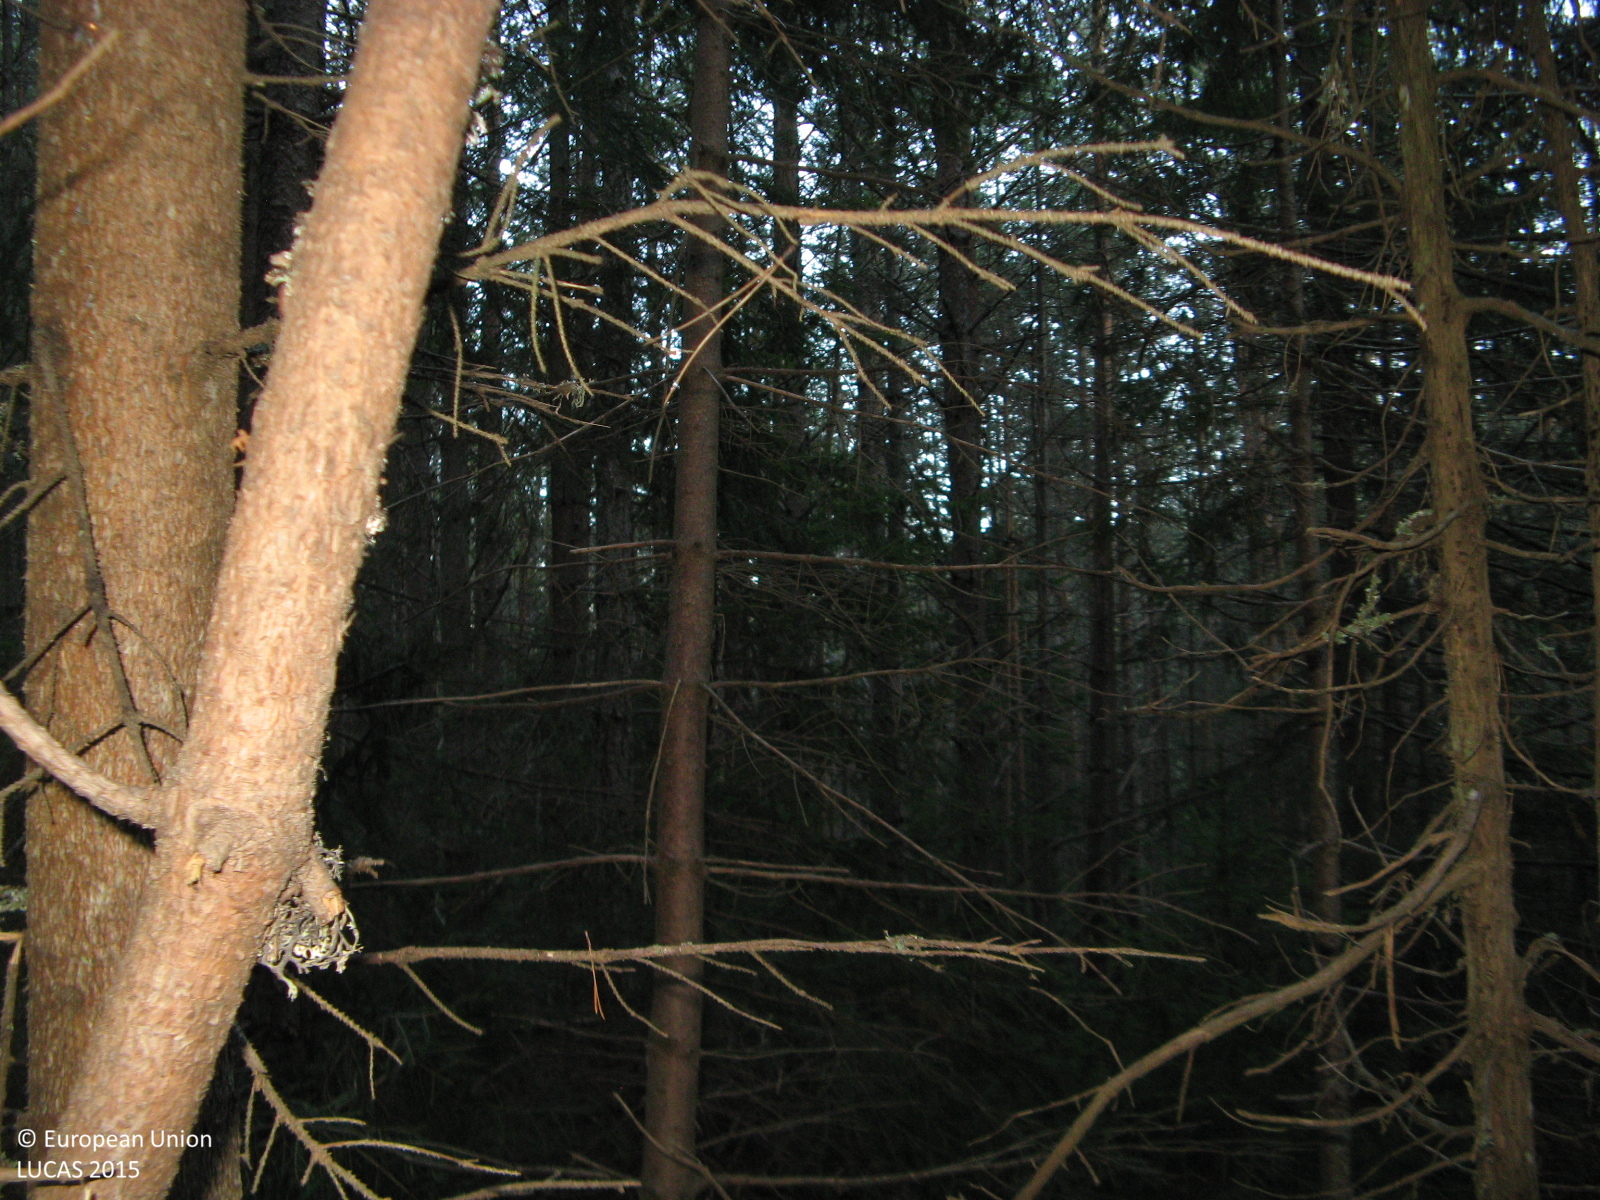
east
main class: Woodland
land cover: Spruce dominated coniferous woodland
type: alpine coniferous forest
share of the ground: > 75 %
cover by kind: coniferous forest trees 90 %, shrubs 5 %, lichens and mosses 5 %
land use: Forestry
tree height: > 5 m
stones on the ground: < 10 %
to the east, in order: Spruce dominated coniferous woodland; Rivers and streams; Spruce dominated coniferous woodland
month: October
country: BG
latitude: 41.8452
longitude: 24.6061
